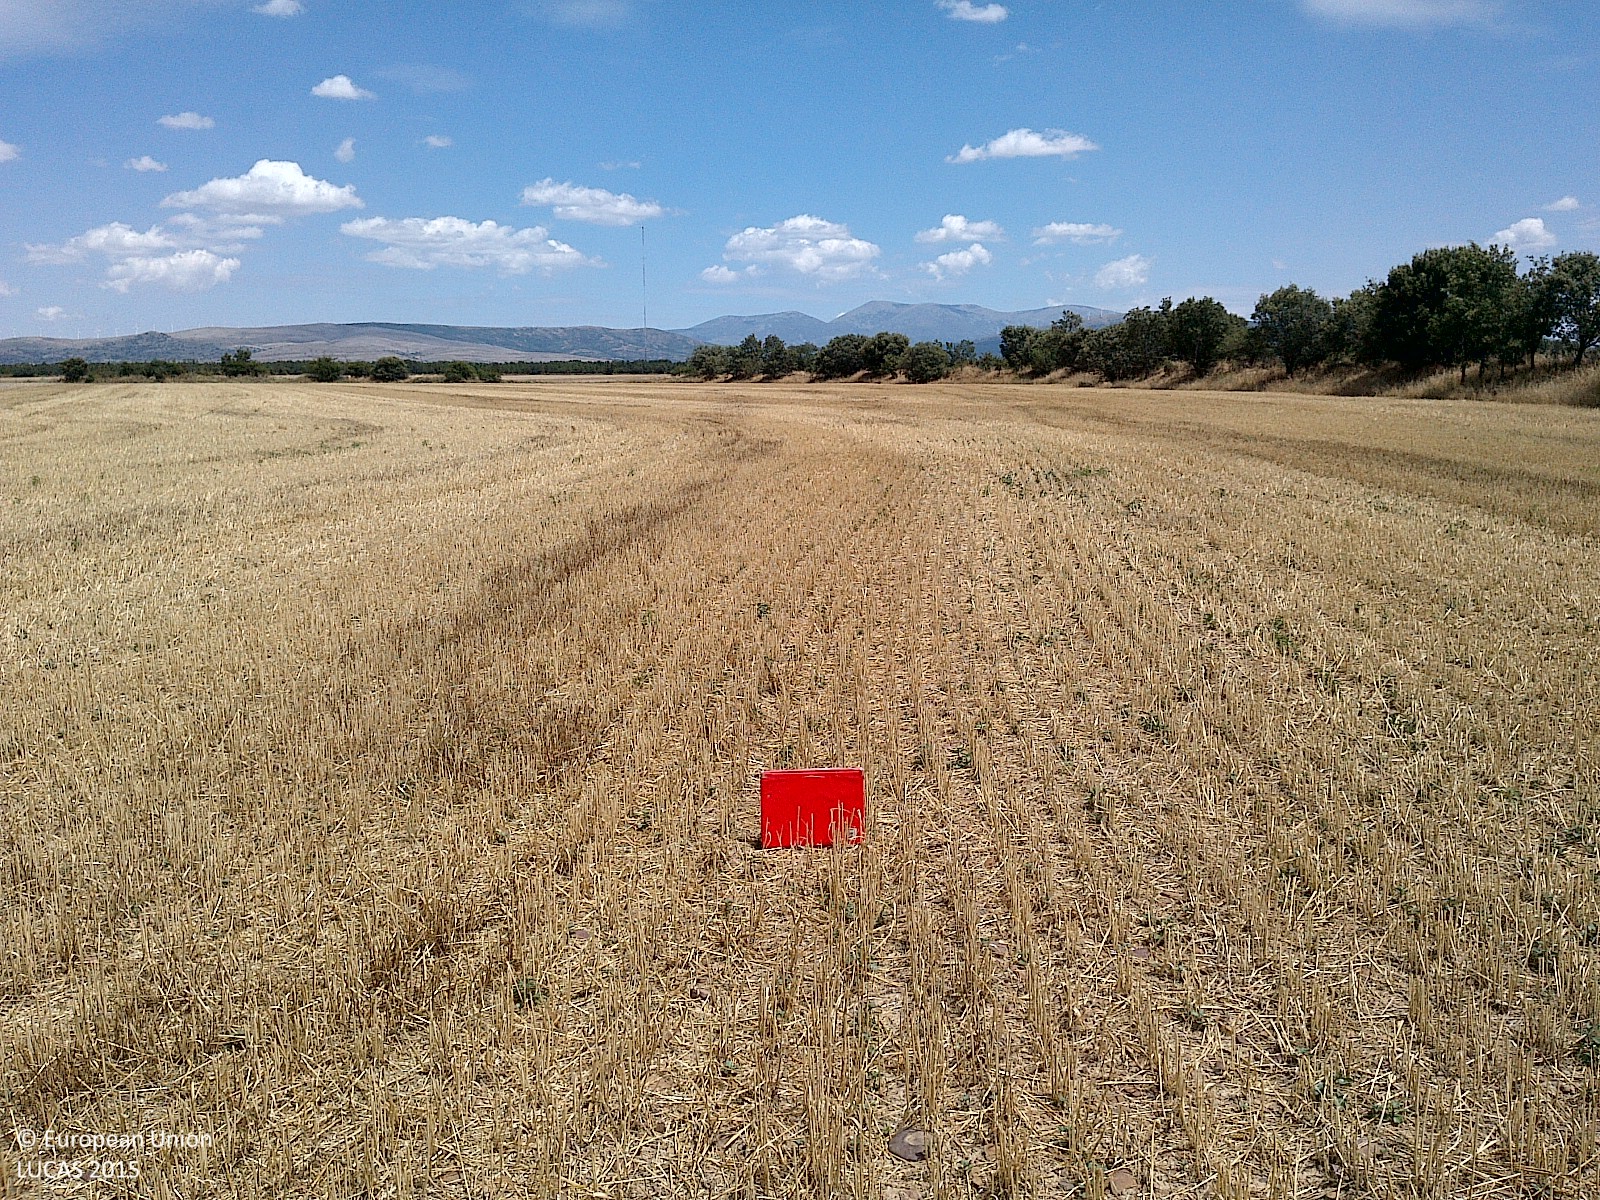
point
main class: Cropland
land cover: Common wheat
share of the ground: < 10 %
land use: Agriculture (excluding fallow land and kitchen gardens)
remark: Harvested field
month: July
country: ES
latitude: 41.6756
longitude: -2.0566
